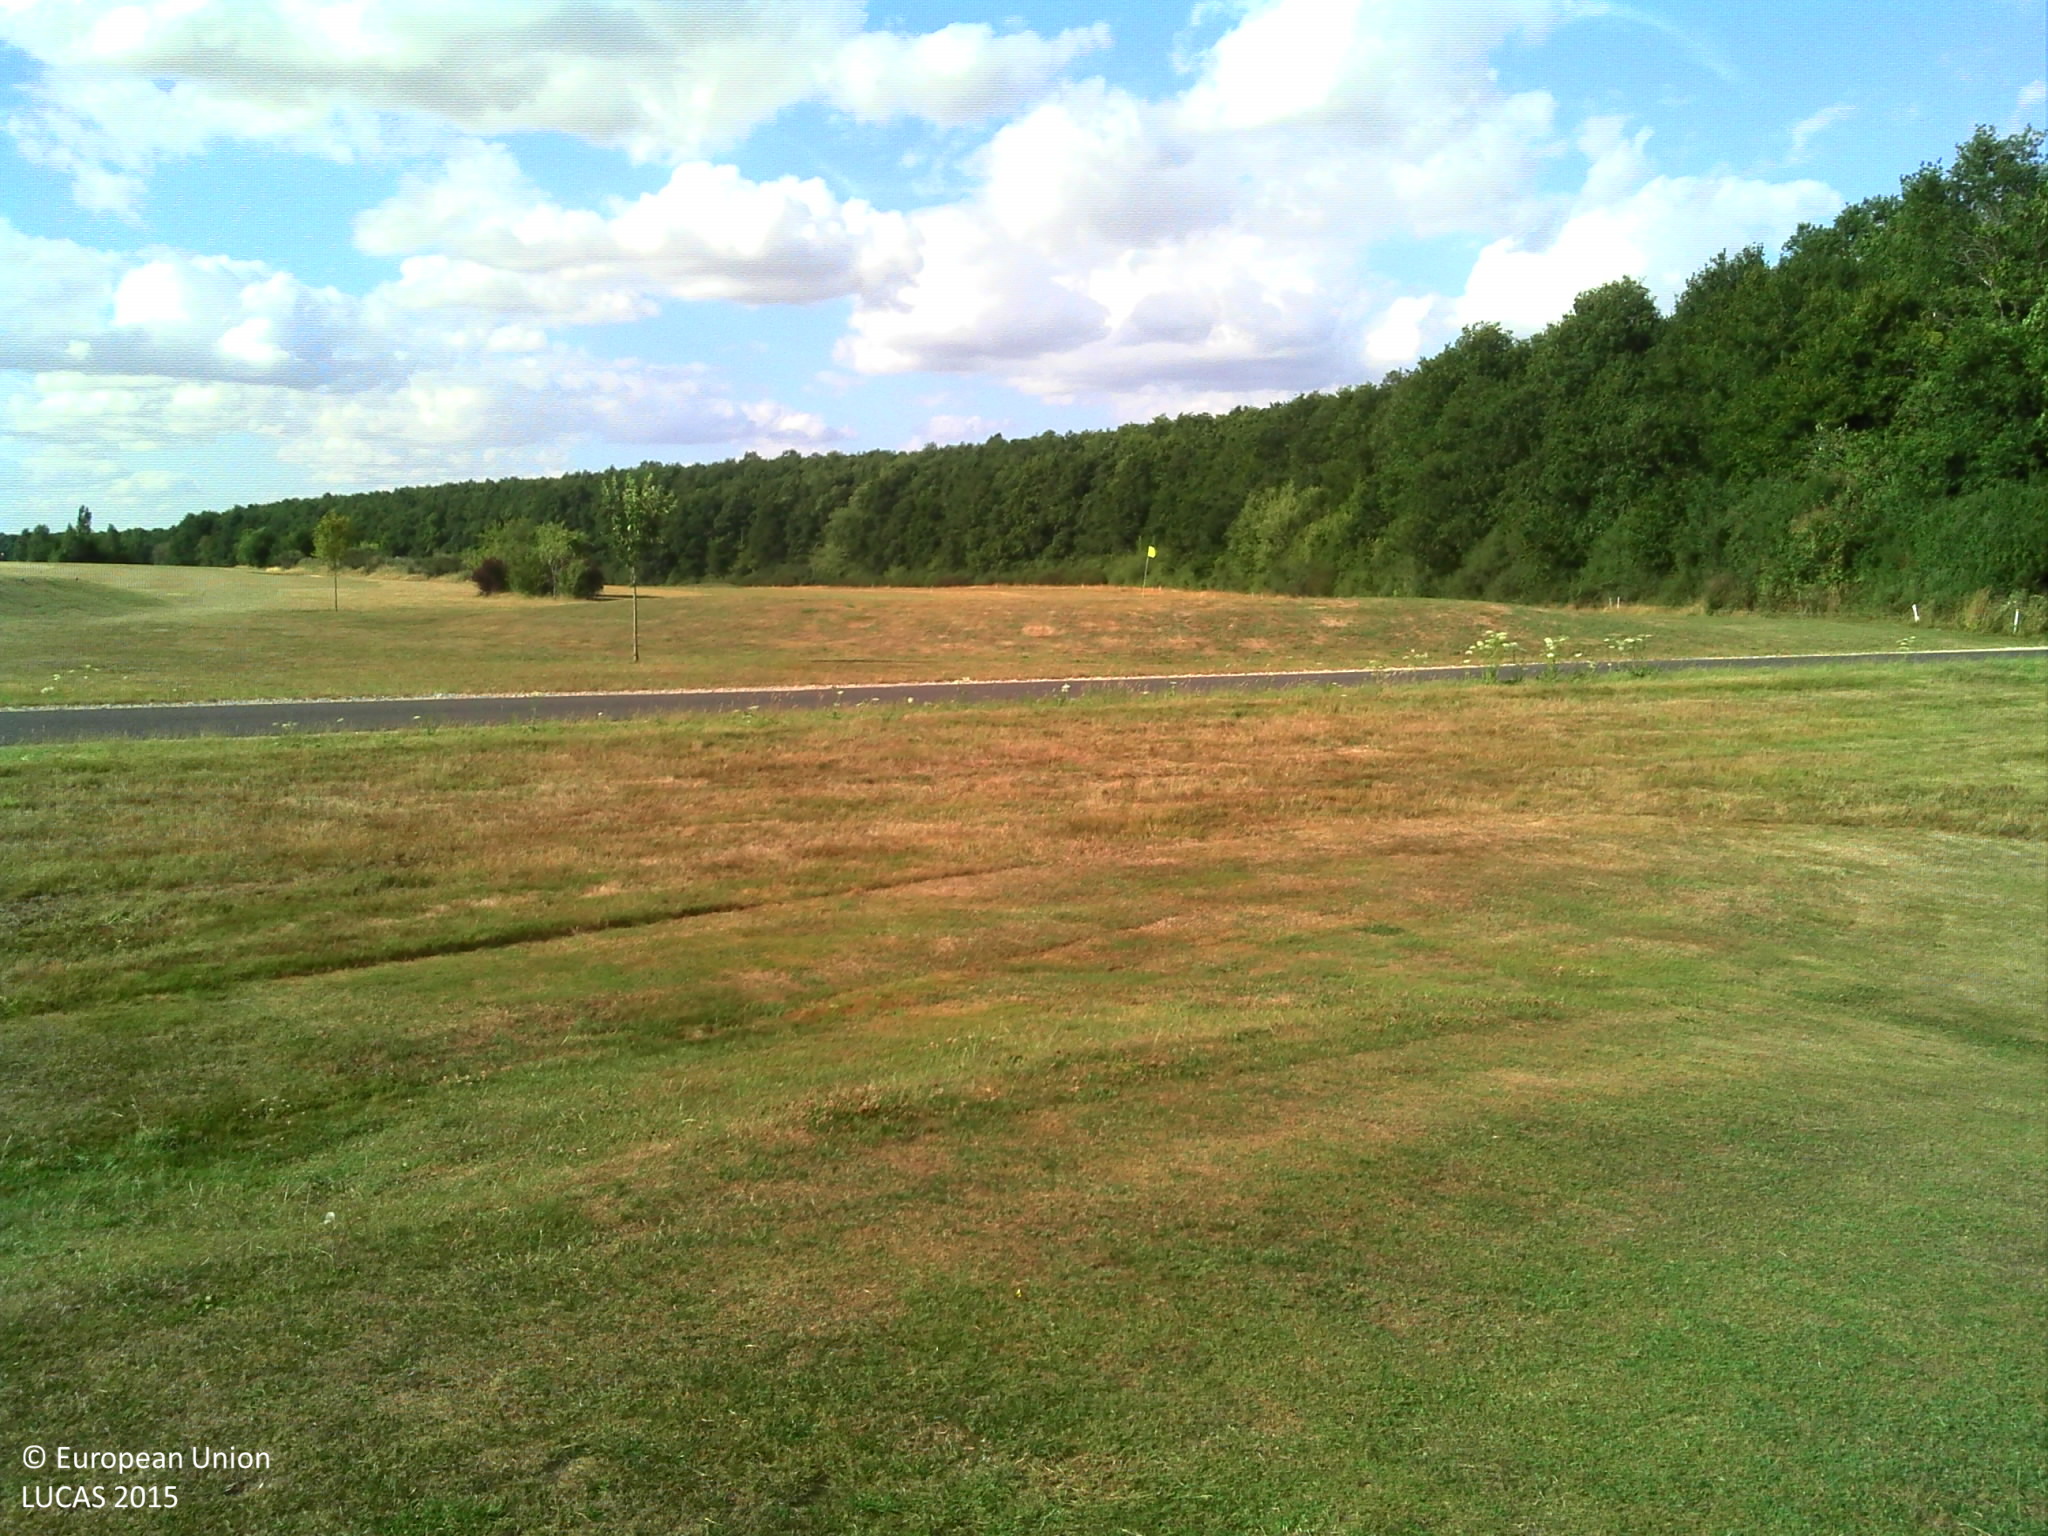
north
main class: Grassland
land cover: Grassland without tree/shrub cover
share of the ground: > 75 %
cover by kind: herbaceous plants 100 %
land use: Sport
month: July
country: FR
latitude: 48.5956
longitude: 1.2080
